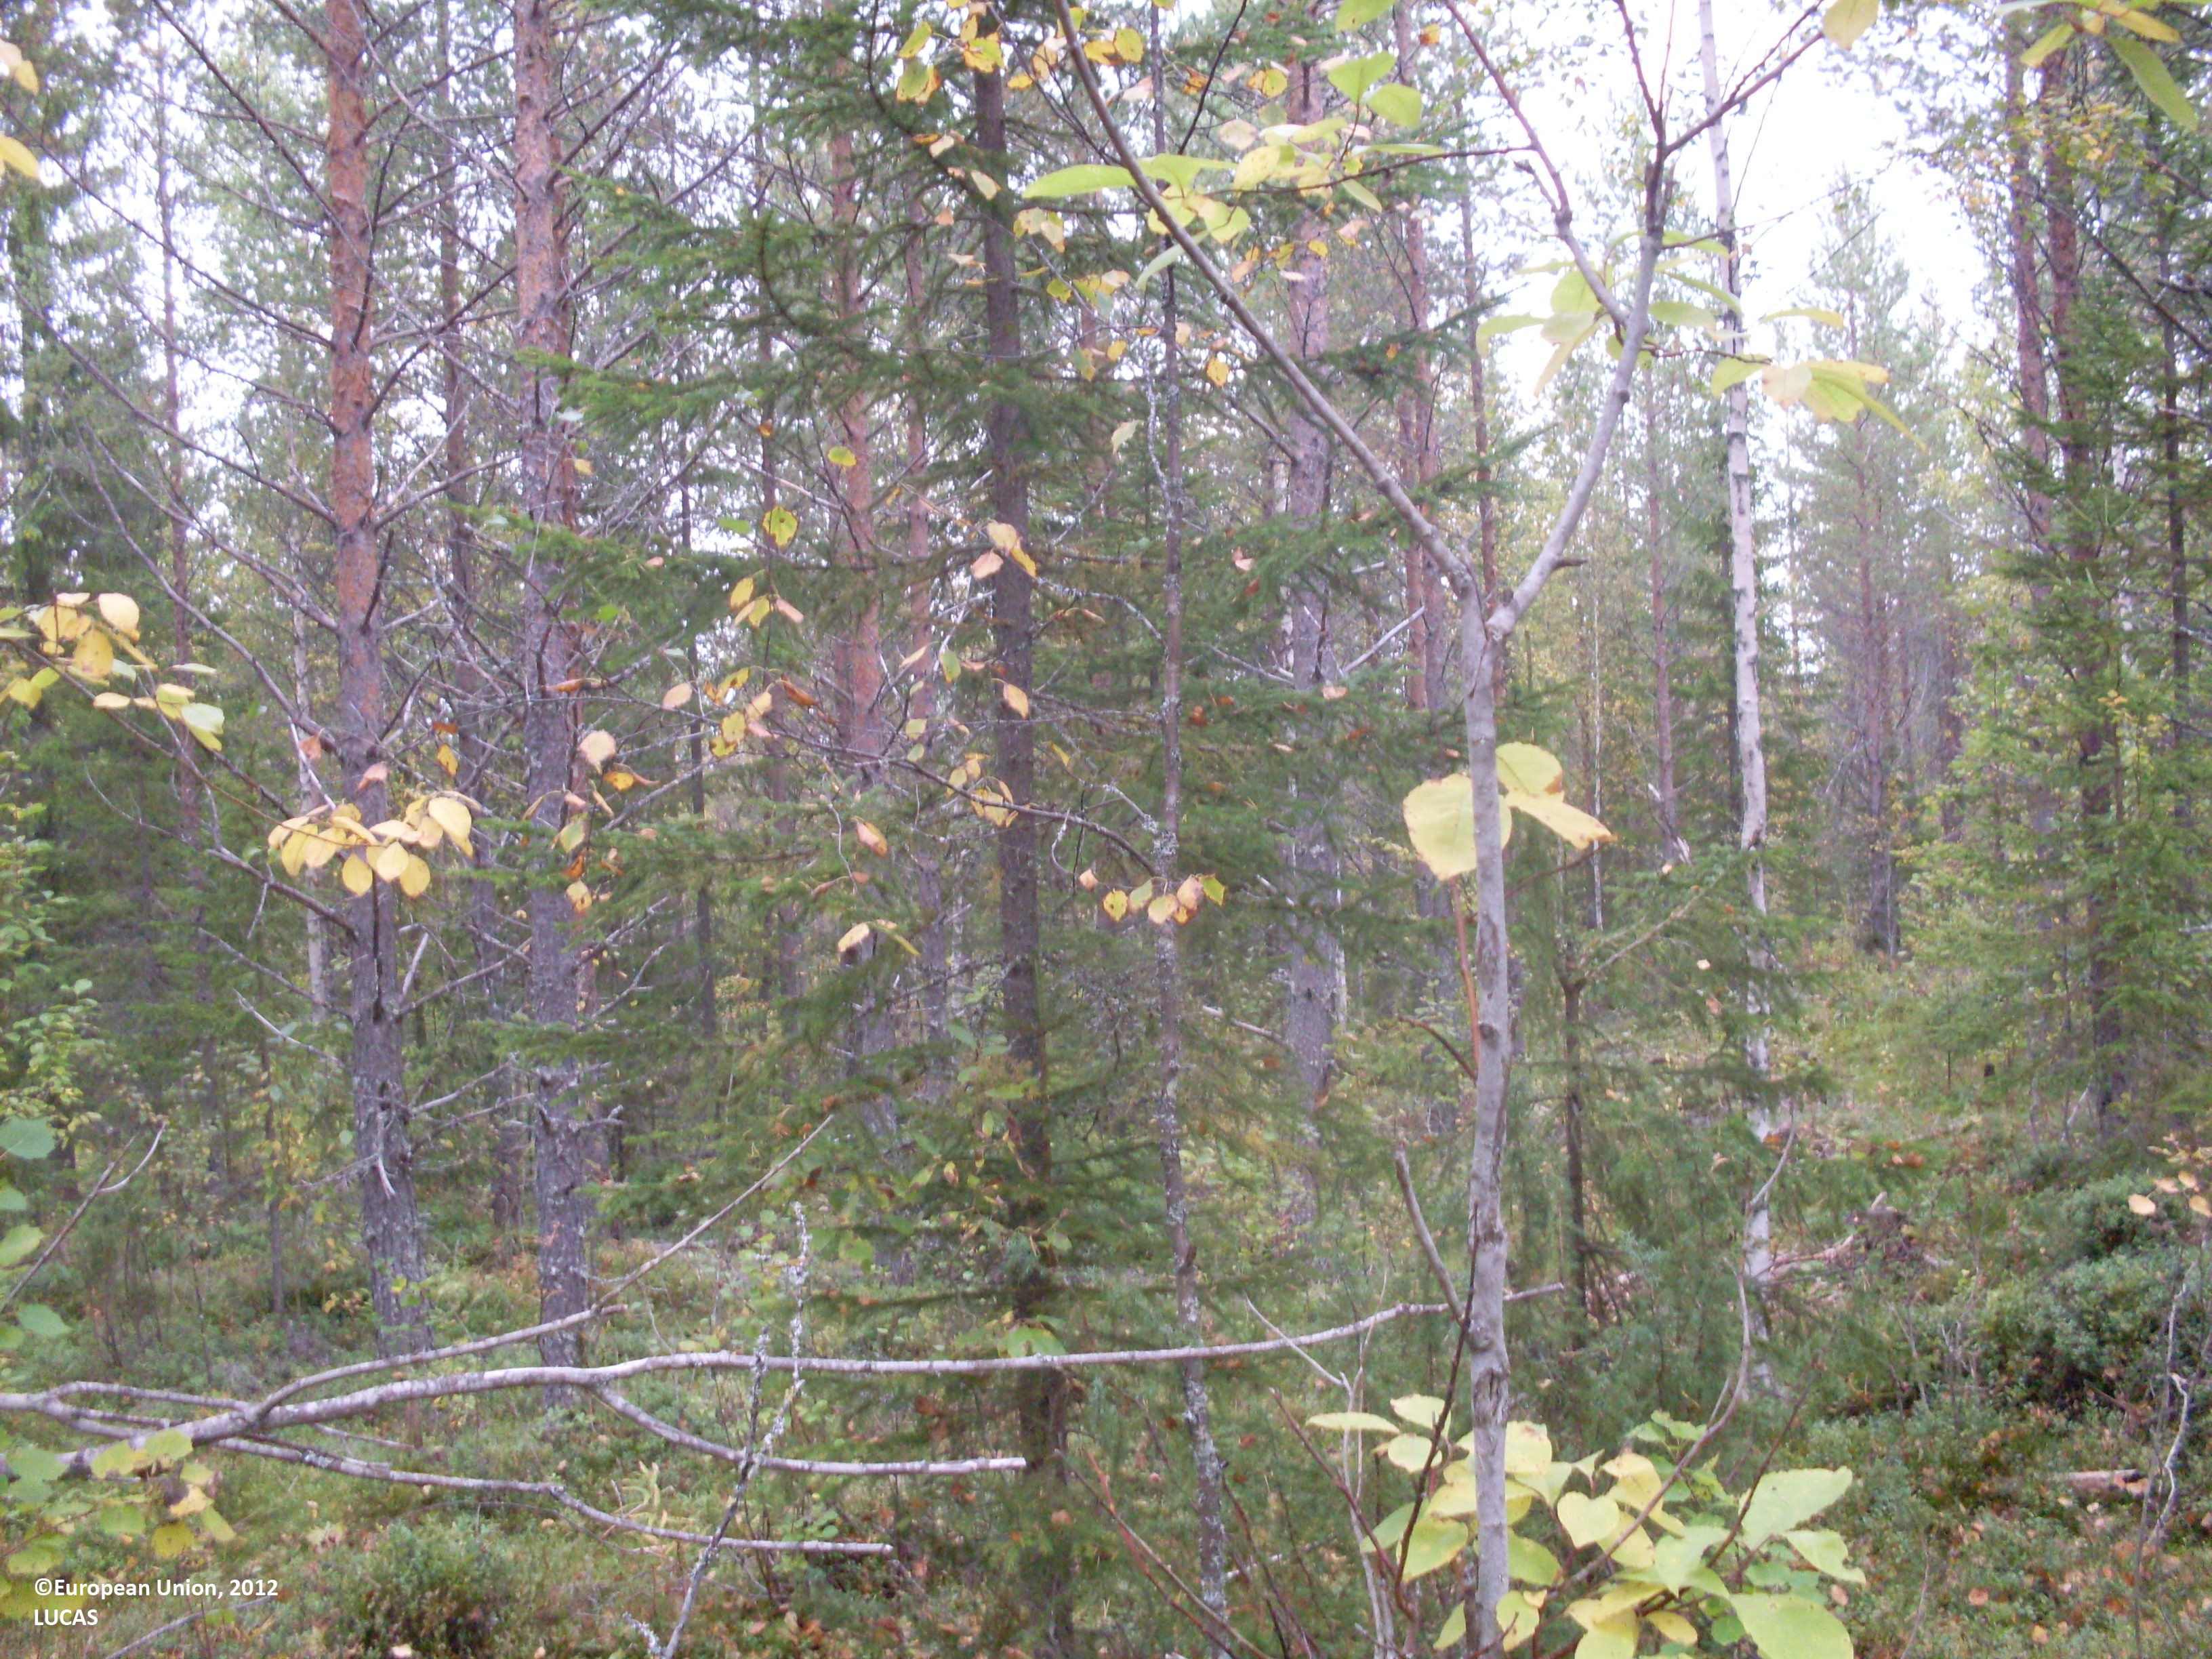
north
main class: Woodland
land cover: Other mixed woodland
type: boreal forest
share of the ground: > 75 %
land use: Forestry
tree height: > 5 m
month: September
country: FI
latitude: 63.9992
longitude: 29.8841
